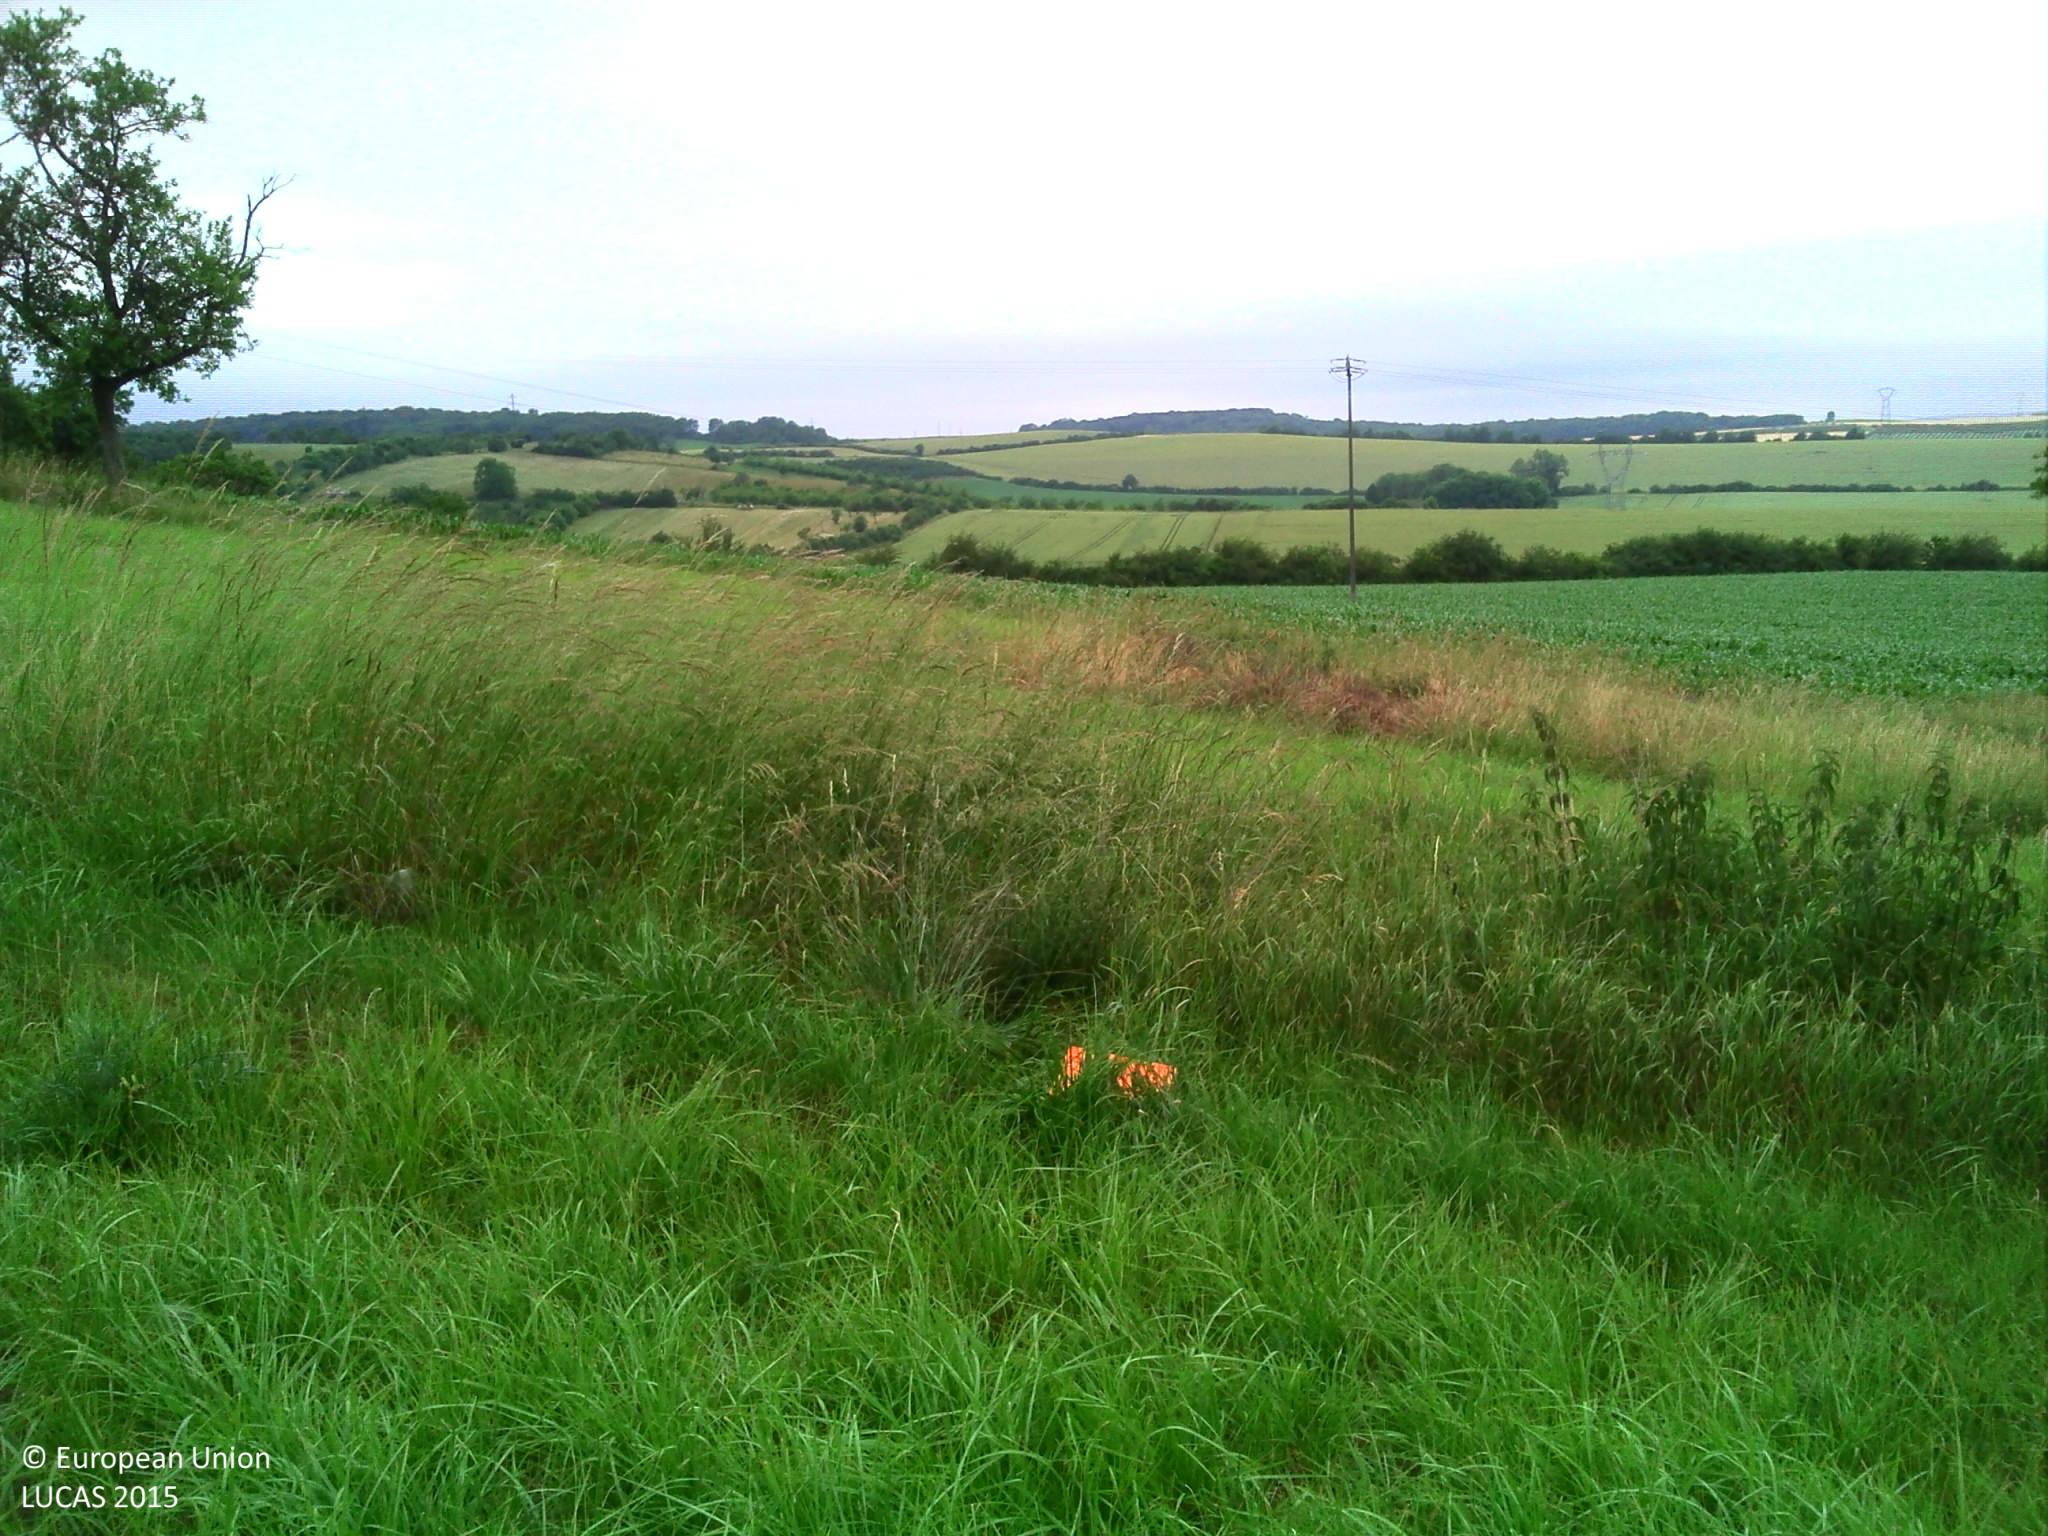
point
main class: Grassland
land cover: Grassland without tree/shrub cover
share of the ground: > 75 %
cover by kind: herbaceous plants 100 %
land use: Agriculture (excluding fallow land and kitchen gardens)
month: June
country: FR
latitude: 48.5578
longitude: 6.3013
